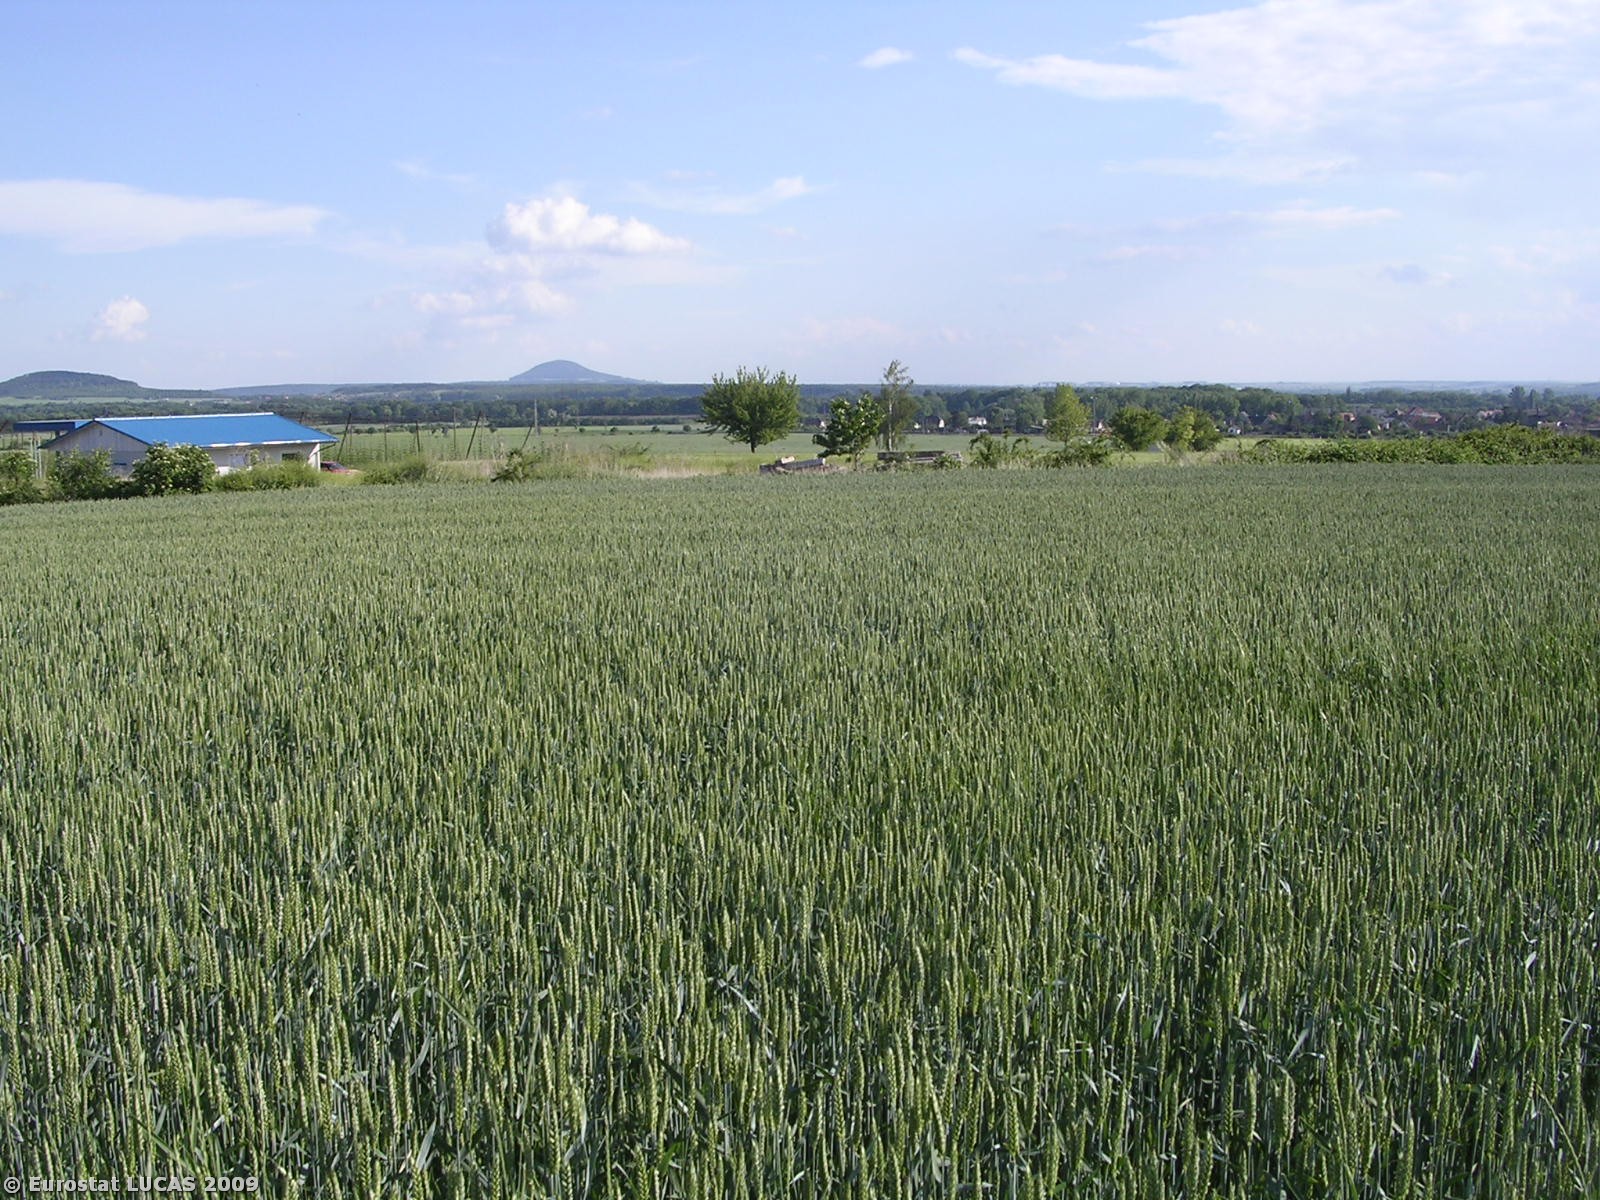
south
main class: Cropland
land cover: Common wheat
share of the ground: > 75 %
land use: Agriculture (excluding fallow land and kitchen gardens)
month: June
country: CZ
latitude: 50.5183
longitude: 14.2749
